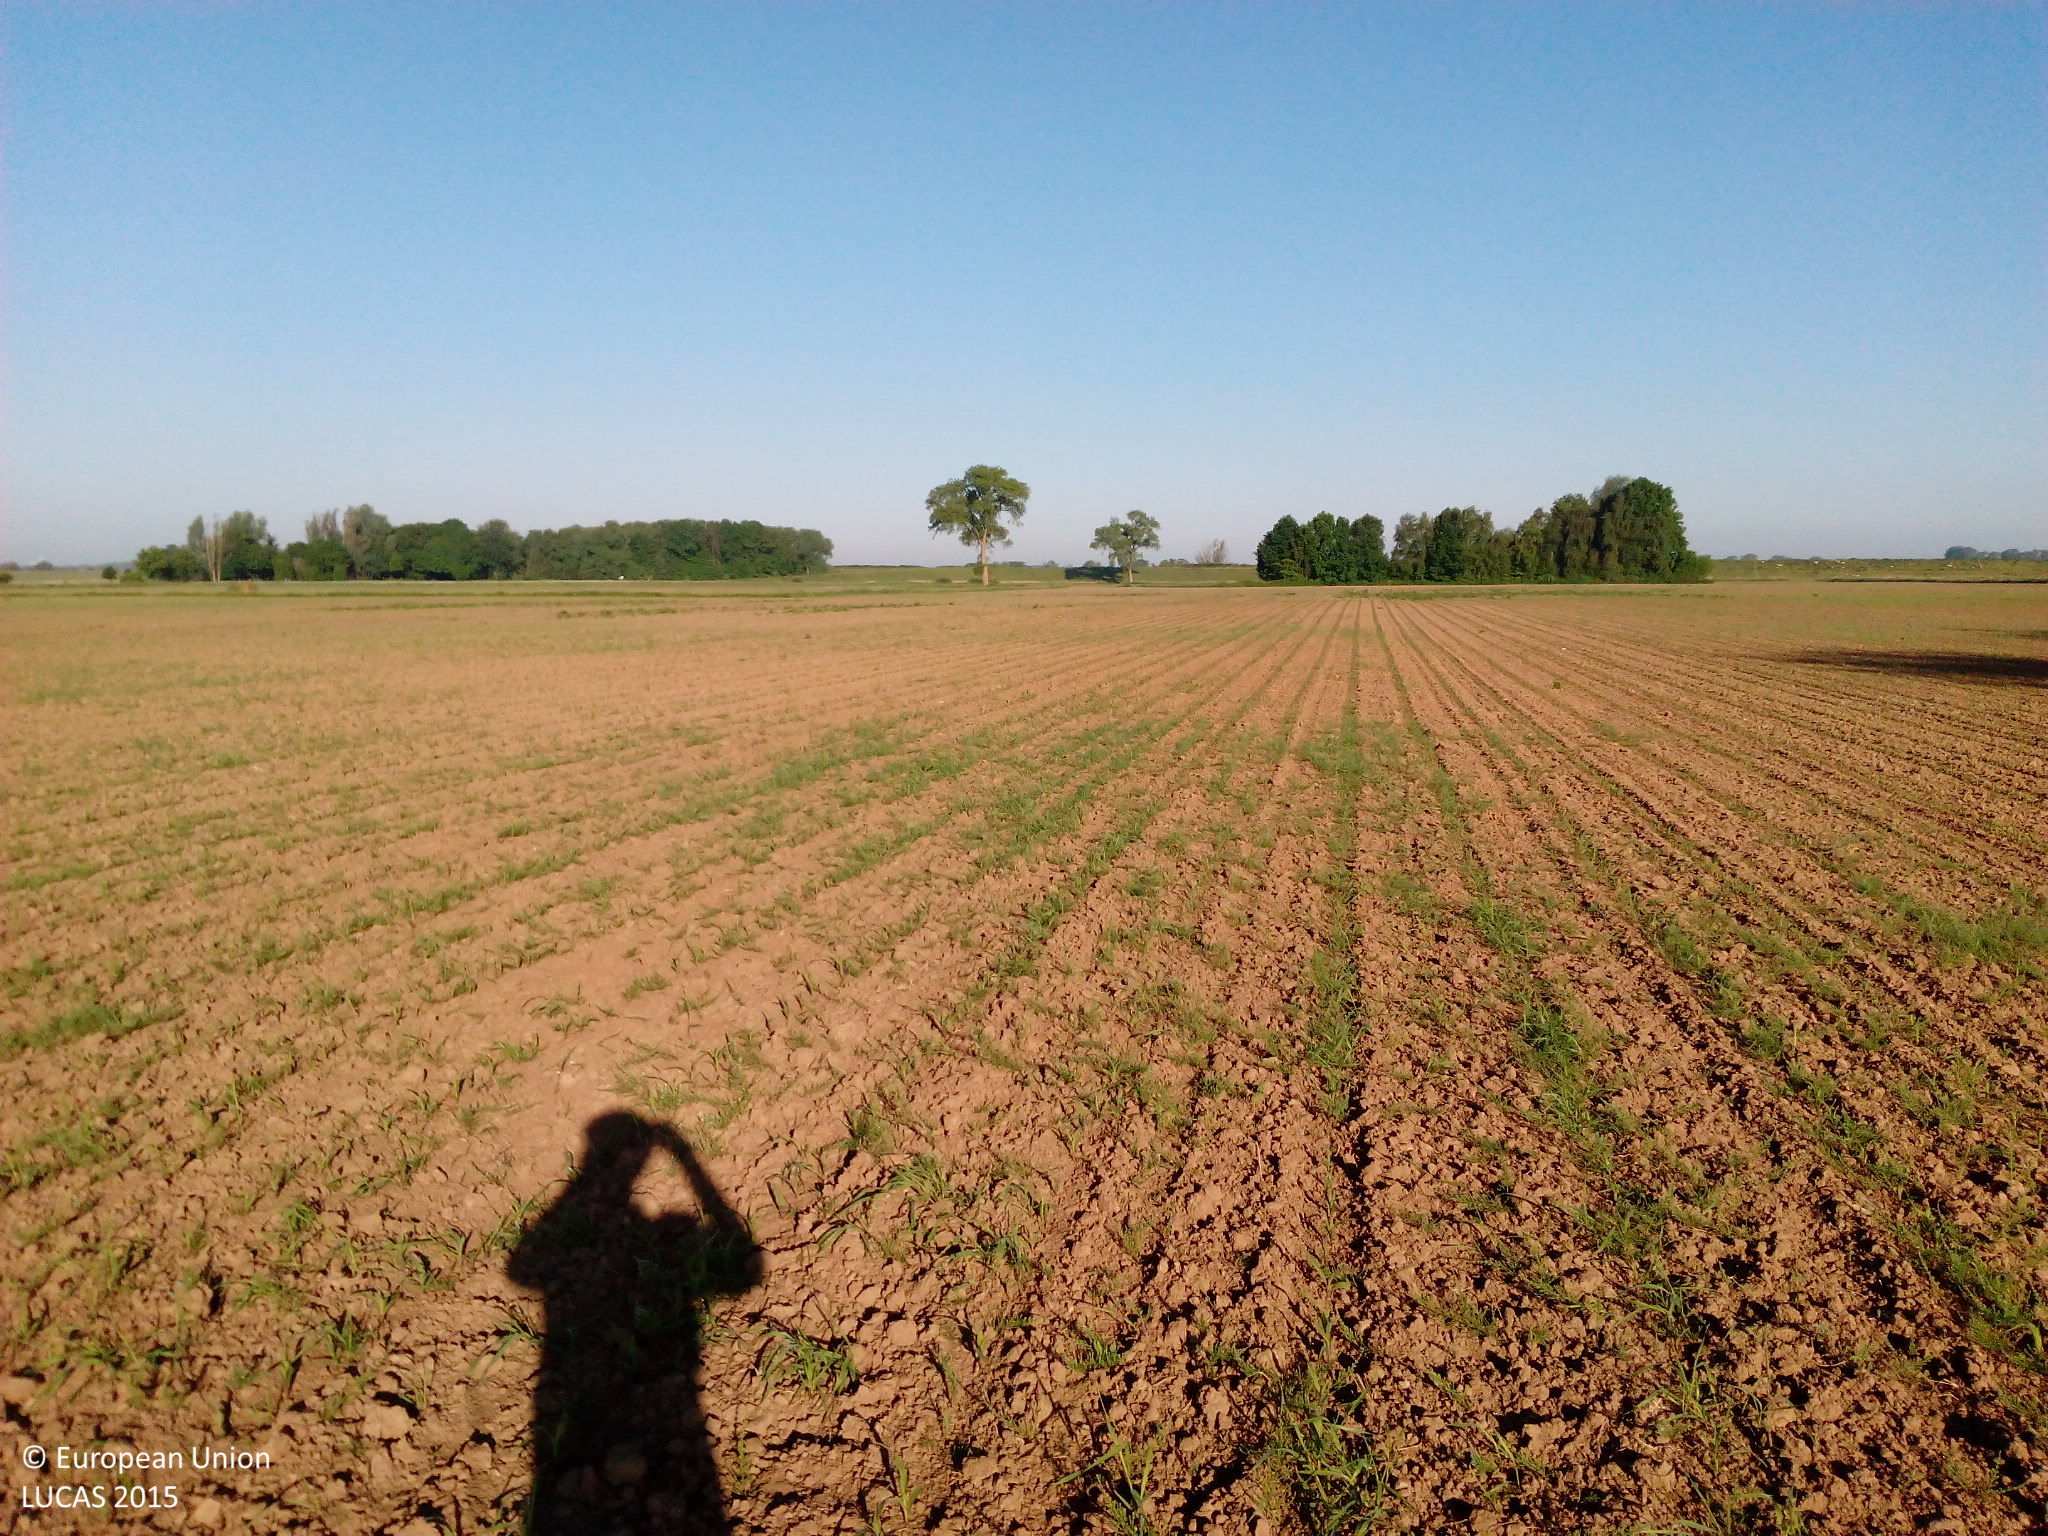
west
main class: Cropland
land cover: Maize
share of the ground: < 10 %
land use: Agriculture (excluding fallow land and kitchen gardens)
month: June
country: DE
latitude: 53.2490
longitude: 8.5169
